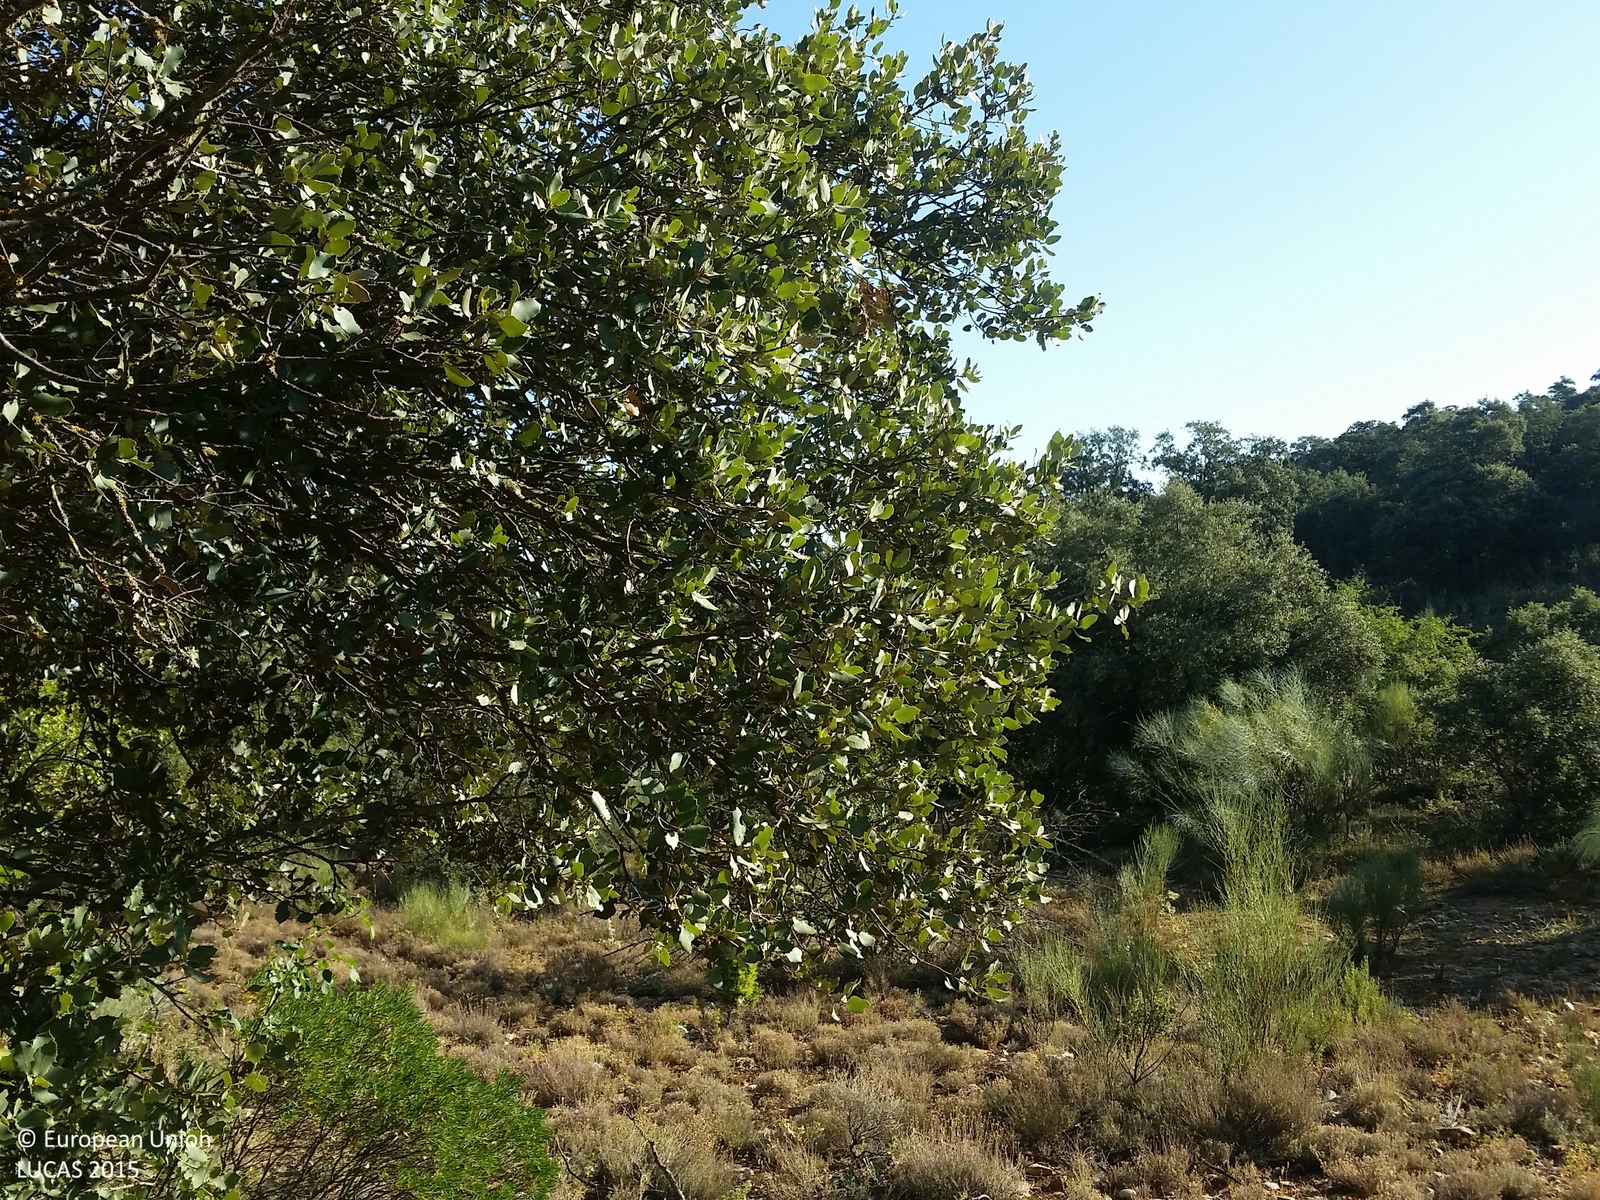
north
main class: Woodland
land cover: Broadleaved woodland
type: broadleaved evergreen forest
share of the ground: 25 - 50 %
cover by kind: broadleaved forest trees 40 %, shrubs 30 %, consolidated bare surface 20 %, herbaceous plants 10 %
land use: Semi-natural and natural areas not in use
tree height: < 5 m
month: July
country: ES
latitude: 38.9729
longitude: -2.4823
